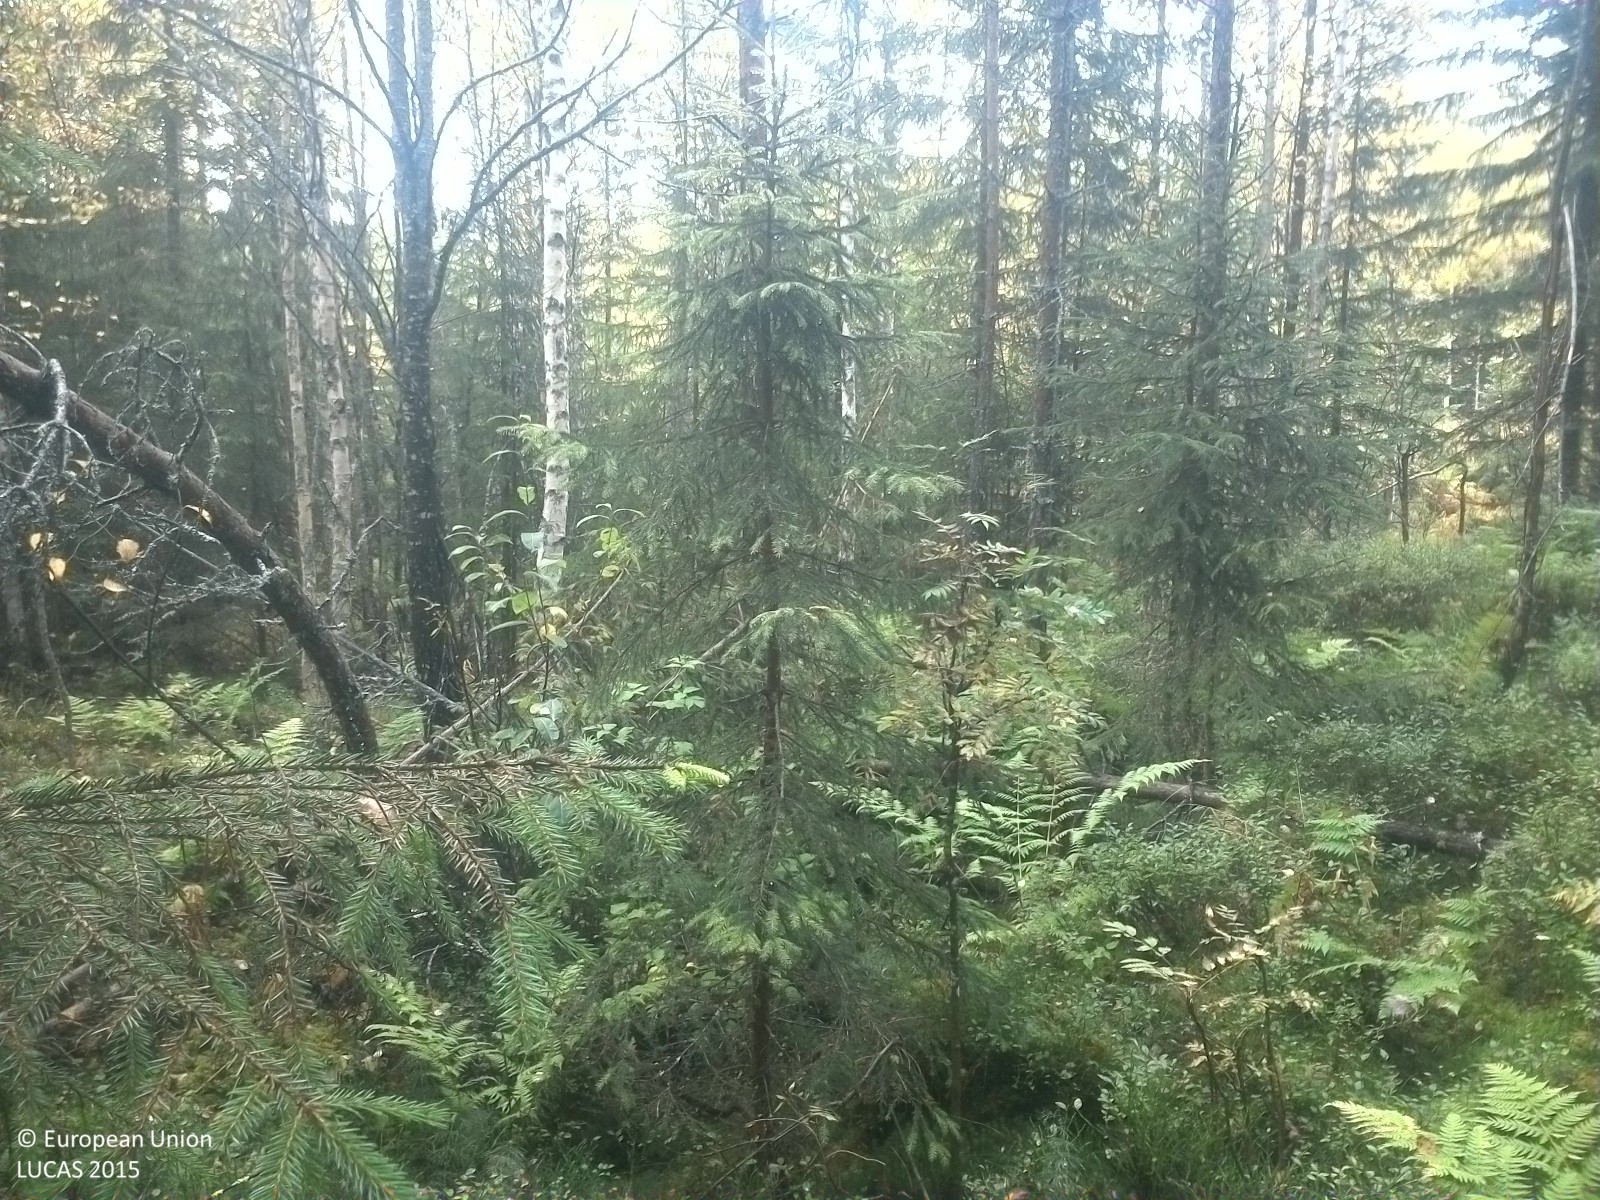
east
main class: Woodland
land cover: Other mixed woodland
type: boreal forest
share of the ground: 50 - 75 %
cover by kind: coniferous forest trees 40 %, lichens and mosses 20 %, broadleaved forest trees 15 %, herbaceous plants 15 %, shrubs 10 %
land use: Forestry
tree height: > 5 m
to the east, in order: Other mixed woodland; Ditches and canals; Paved roads, cycling and walking lanes; Ditches and canals; Other mixed woodland; Pine dominated mixed woodland; Electric lines; Shrubland with sparse tree cover; Tracks; Shrubland with sparse tree cover; Spruce dominated mixed woodland
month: September
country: SE
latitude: 62.1301
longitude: 15.5614
